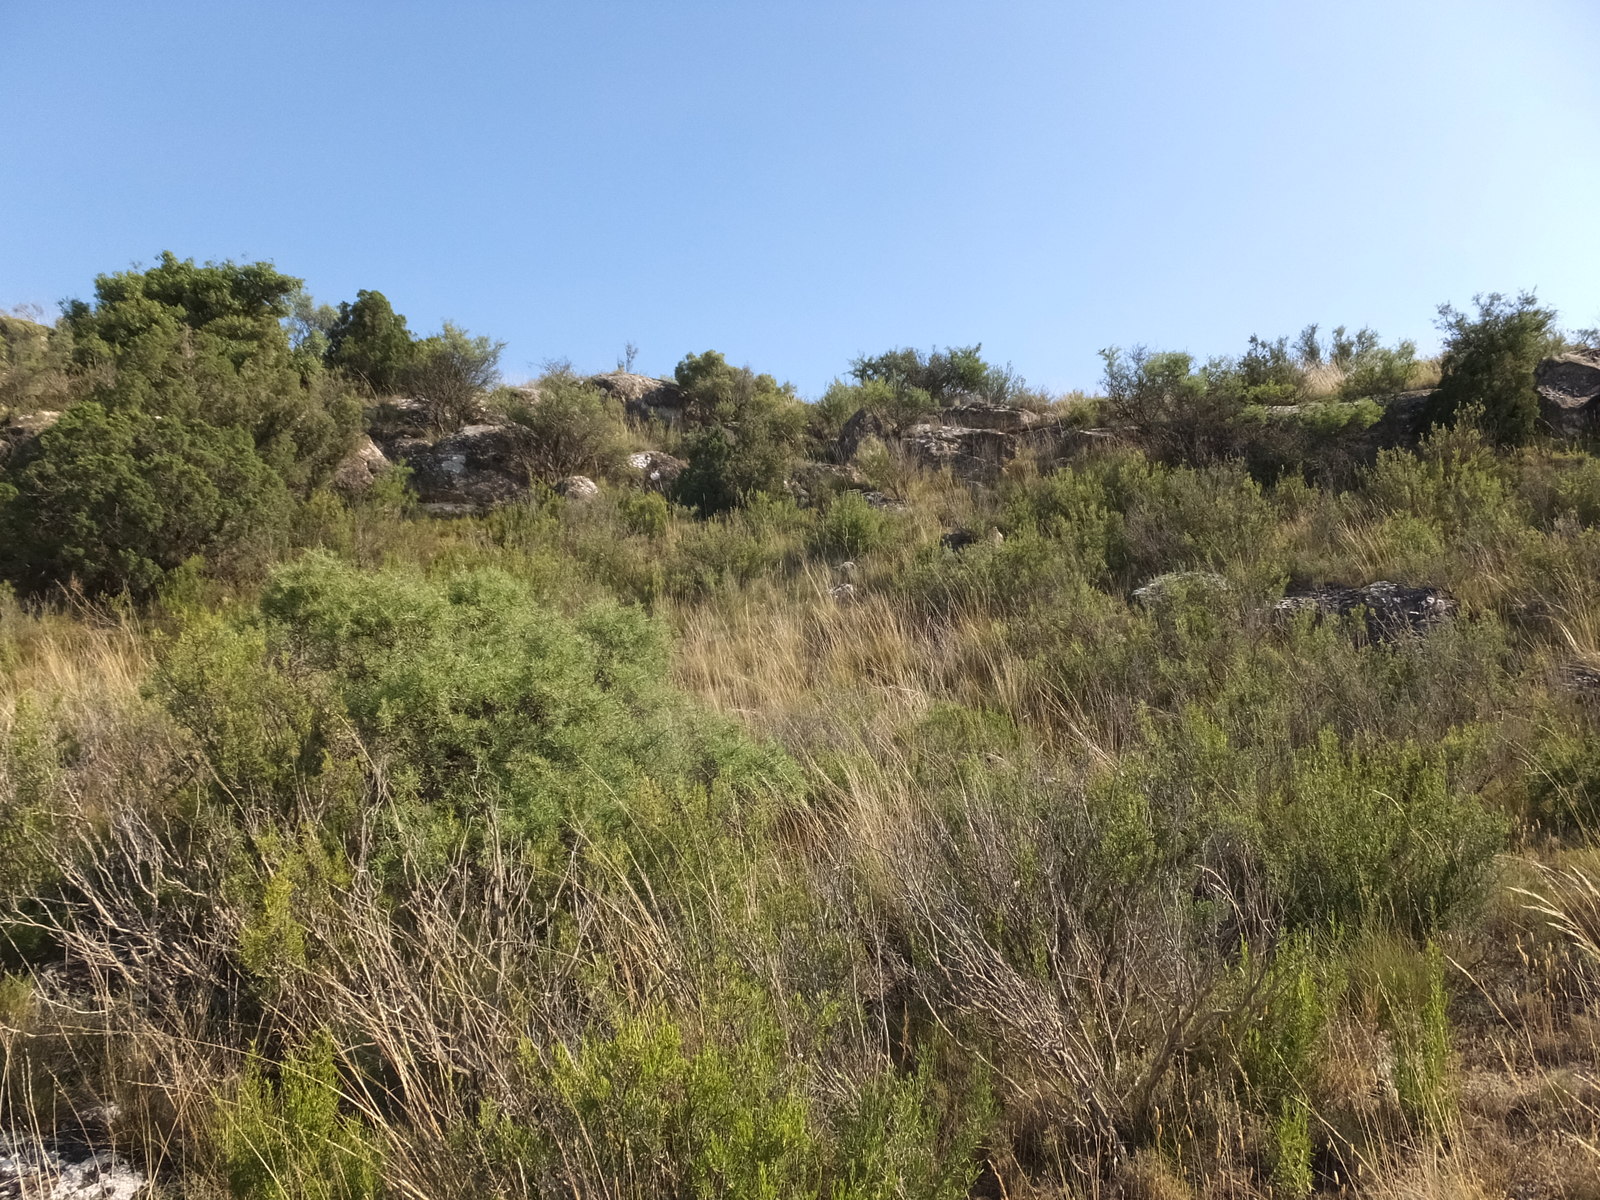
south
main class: Shrubland
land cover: Shrubland without tree cover
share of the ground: > 75 %
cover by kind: shrubs 50 %, herbaceous plants 50 %
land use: Semi-natural and natural areas not in use
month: June
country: ES
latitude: 41.2087
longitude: -0.2101
